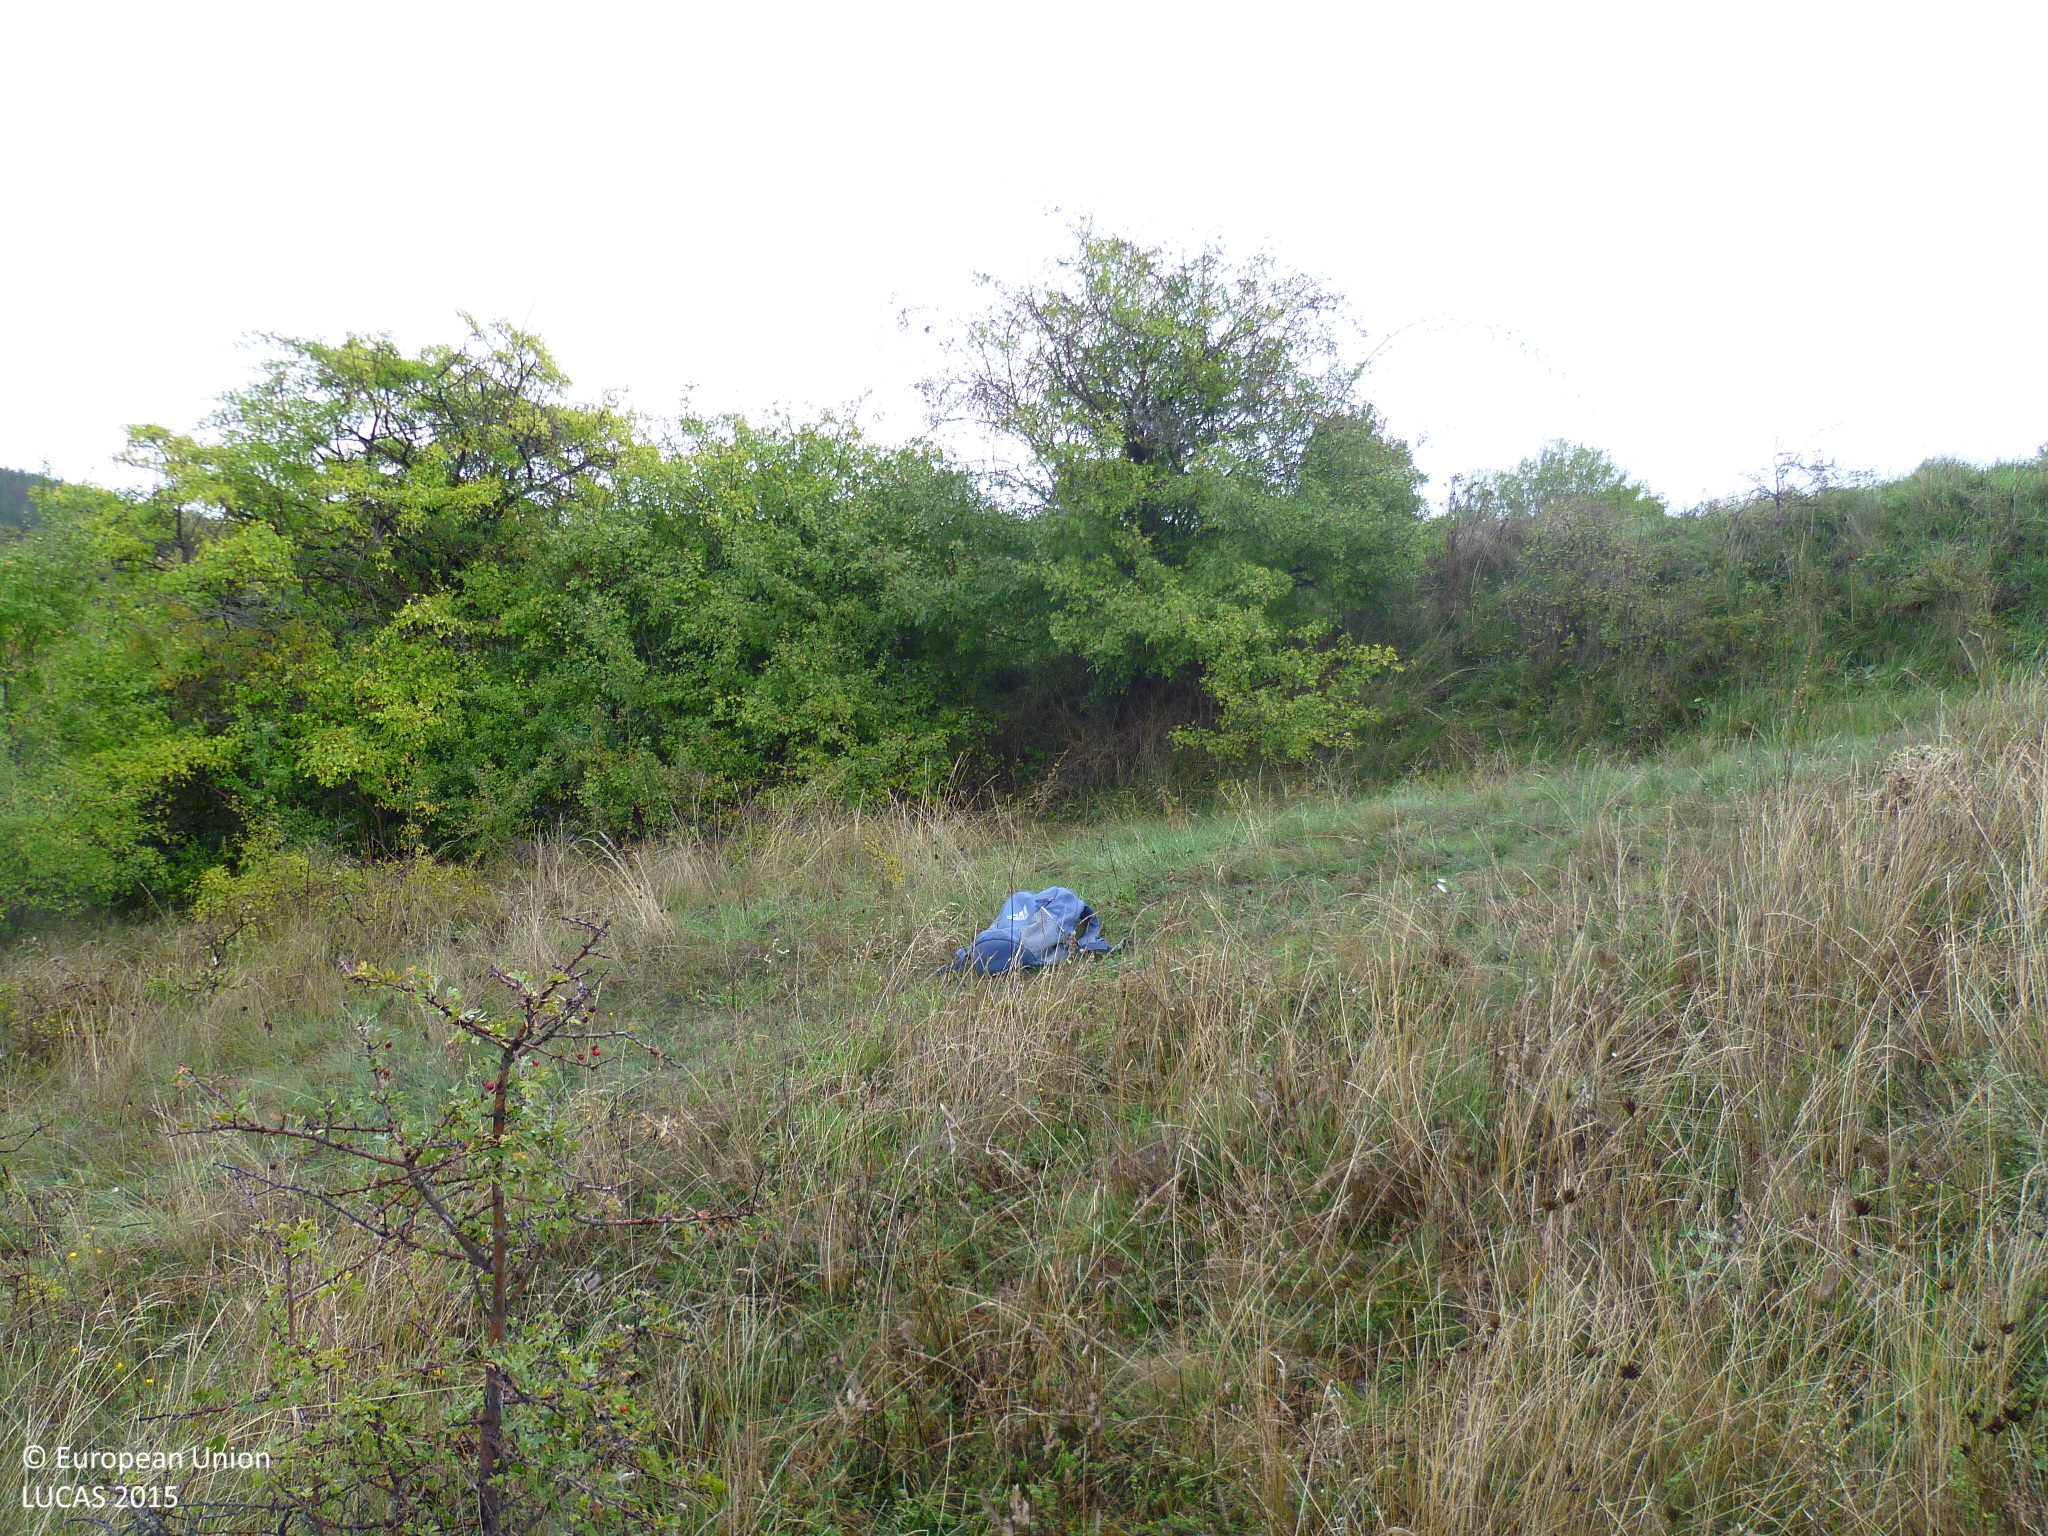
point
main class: Grassland
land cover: Grassland with sparse tree/shrub cover
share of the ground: > 75 %
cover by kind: herbaceous plants 90 %, broadleaved forest trees 5 %, shrubs 5 %
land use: Agriculture (excluding fallow land and kitchen gardens)
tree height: < 5 m
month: September
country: BG
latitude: 42.6838
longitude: 22.7555
